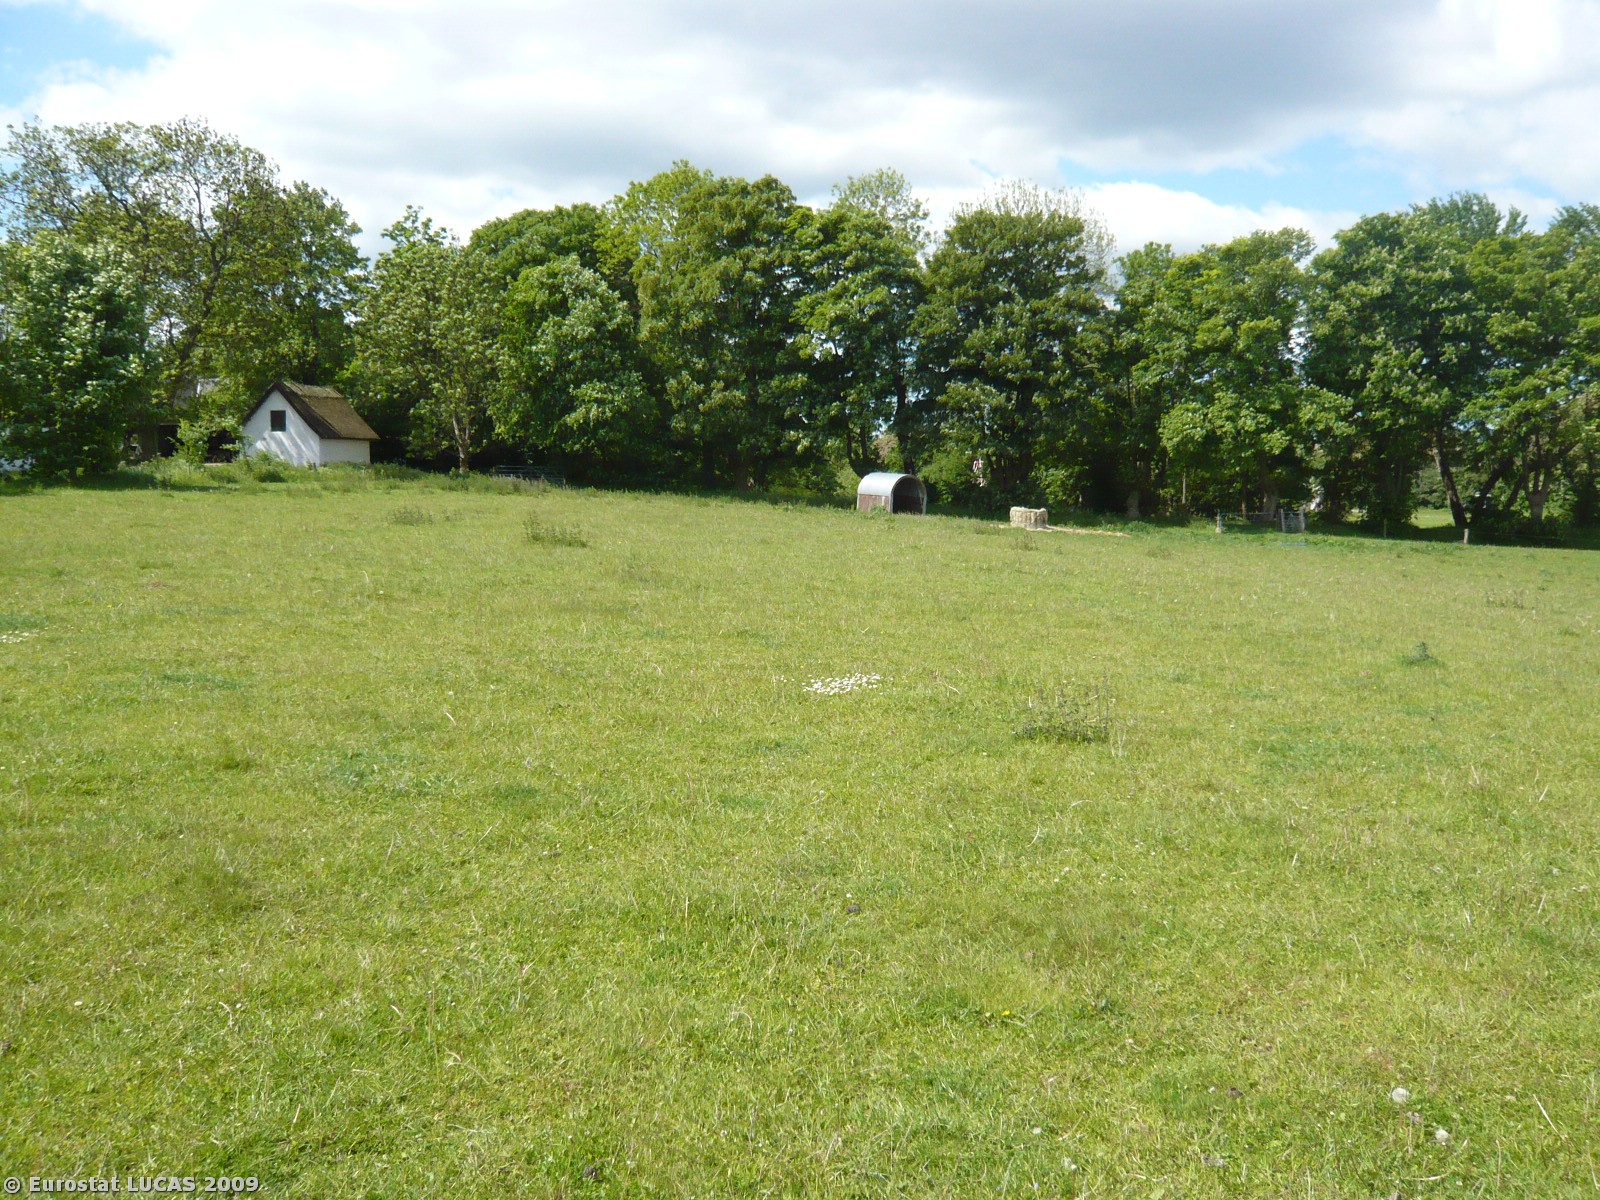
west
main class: Grassland
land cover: Grassland without tree/shrub cover
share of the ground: > 75 %
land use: Agriculture (excluding fallow land and kitchen gardens)
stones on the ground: < 10 %
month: May
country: DK
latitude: 55.7349
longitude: 12.3391
